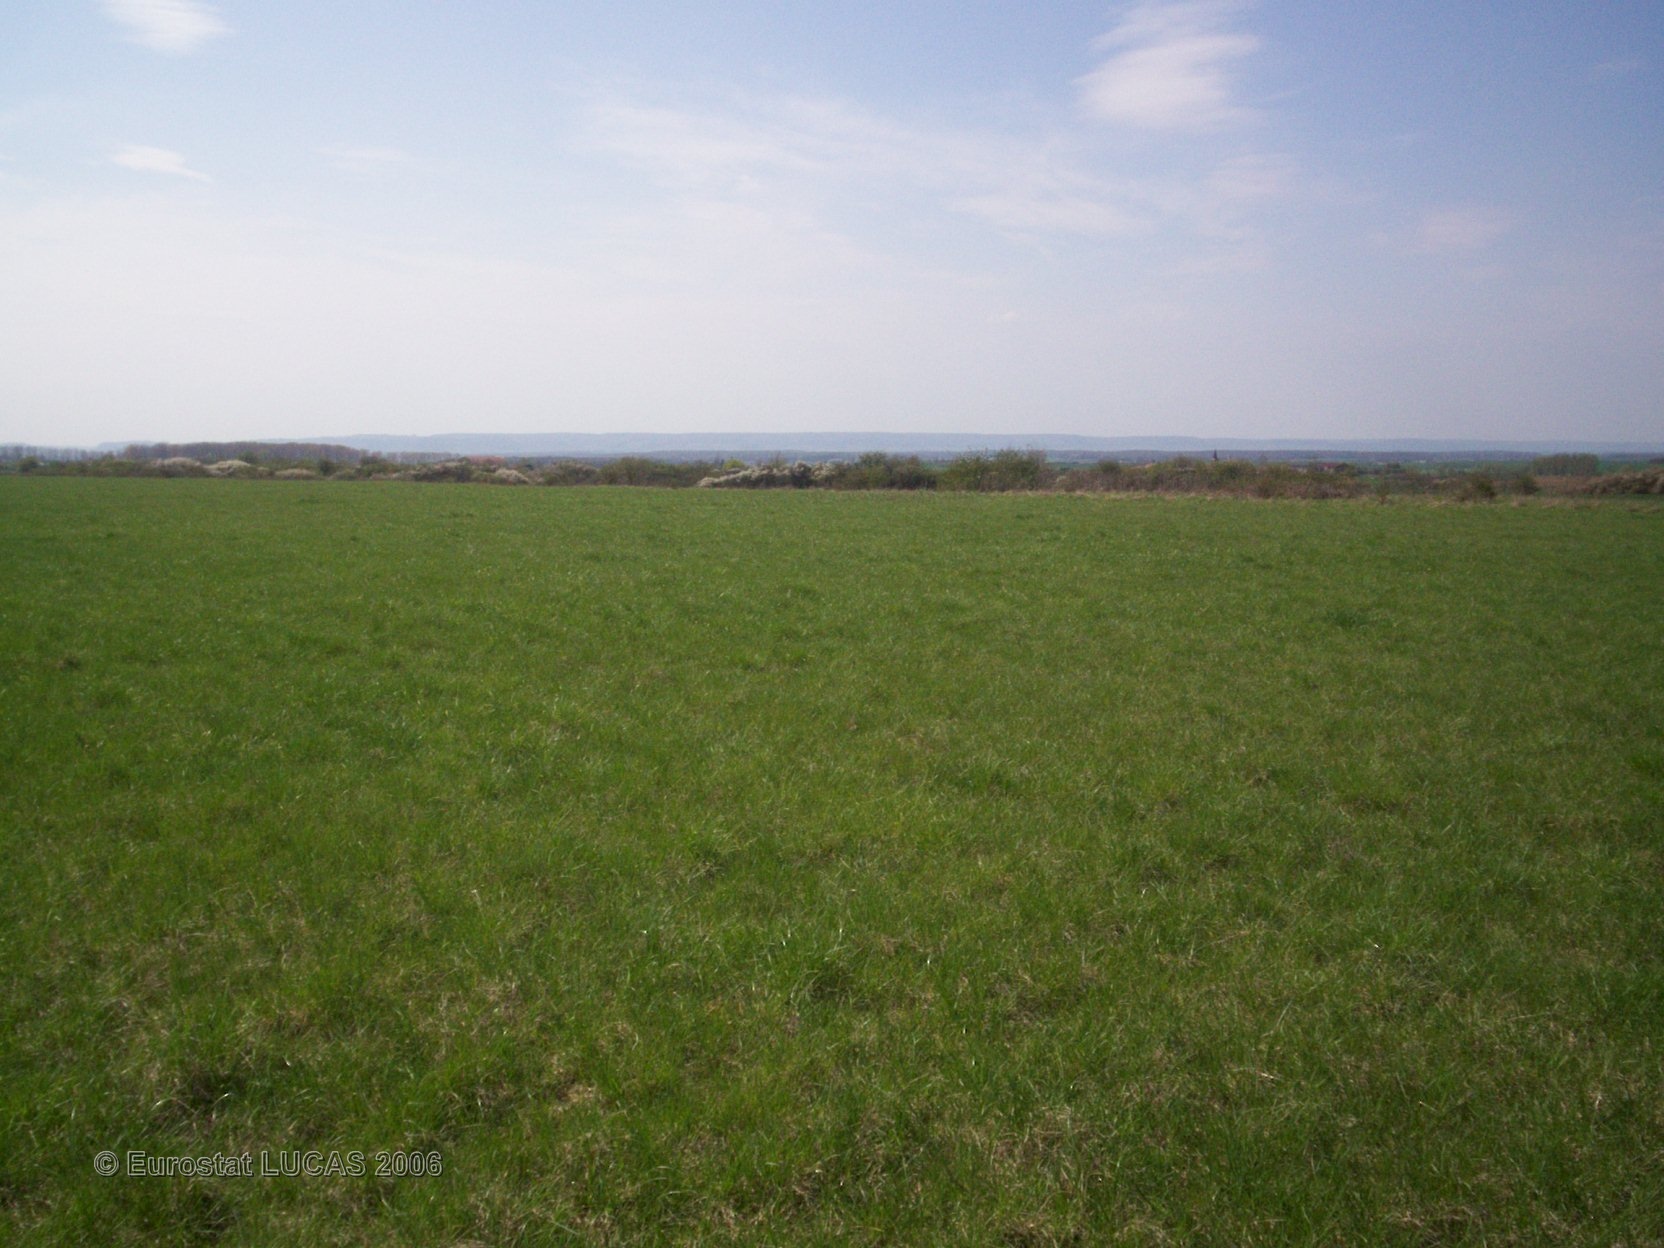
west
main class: Grassland
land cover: Grassland without tree/shrub cover
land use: Amenities, museums, leisure
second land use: Air transport
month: April
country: FR
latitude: 49.0294
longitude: 5.8827
